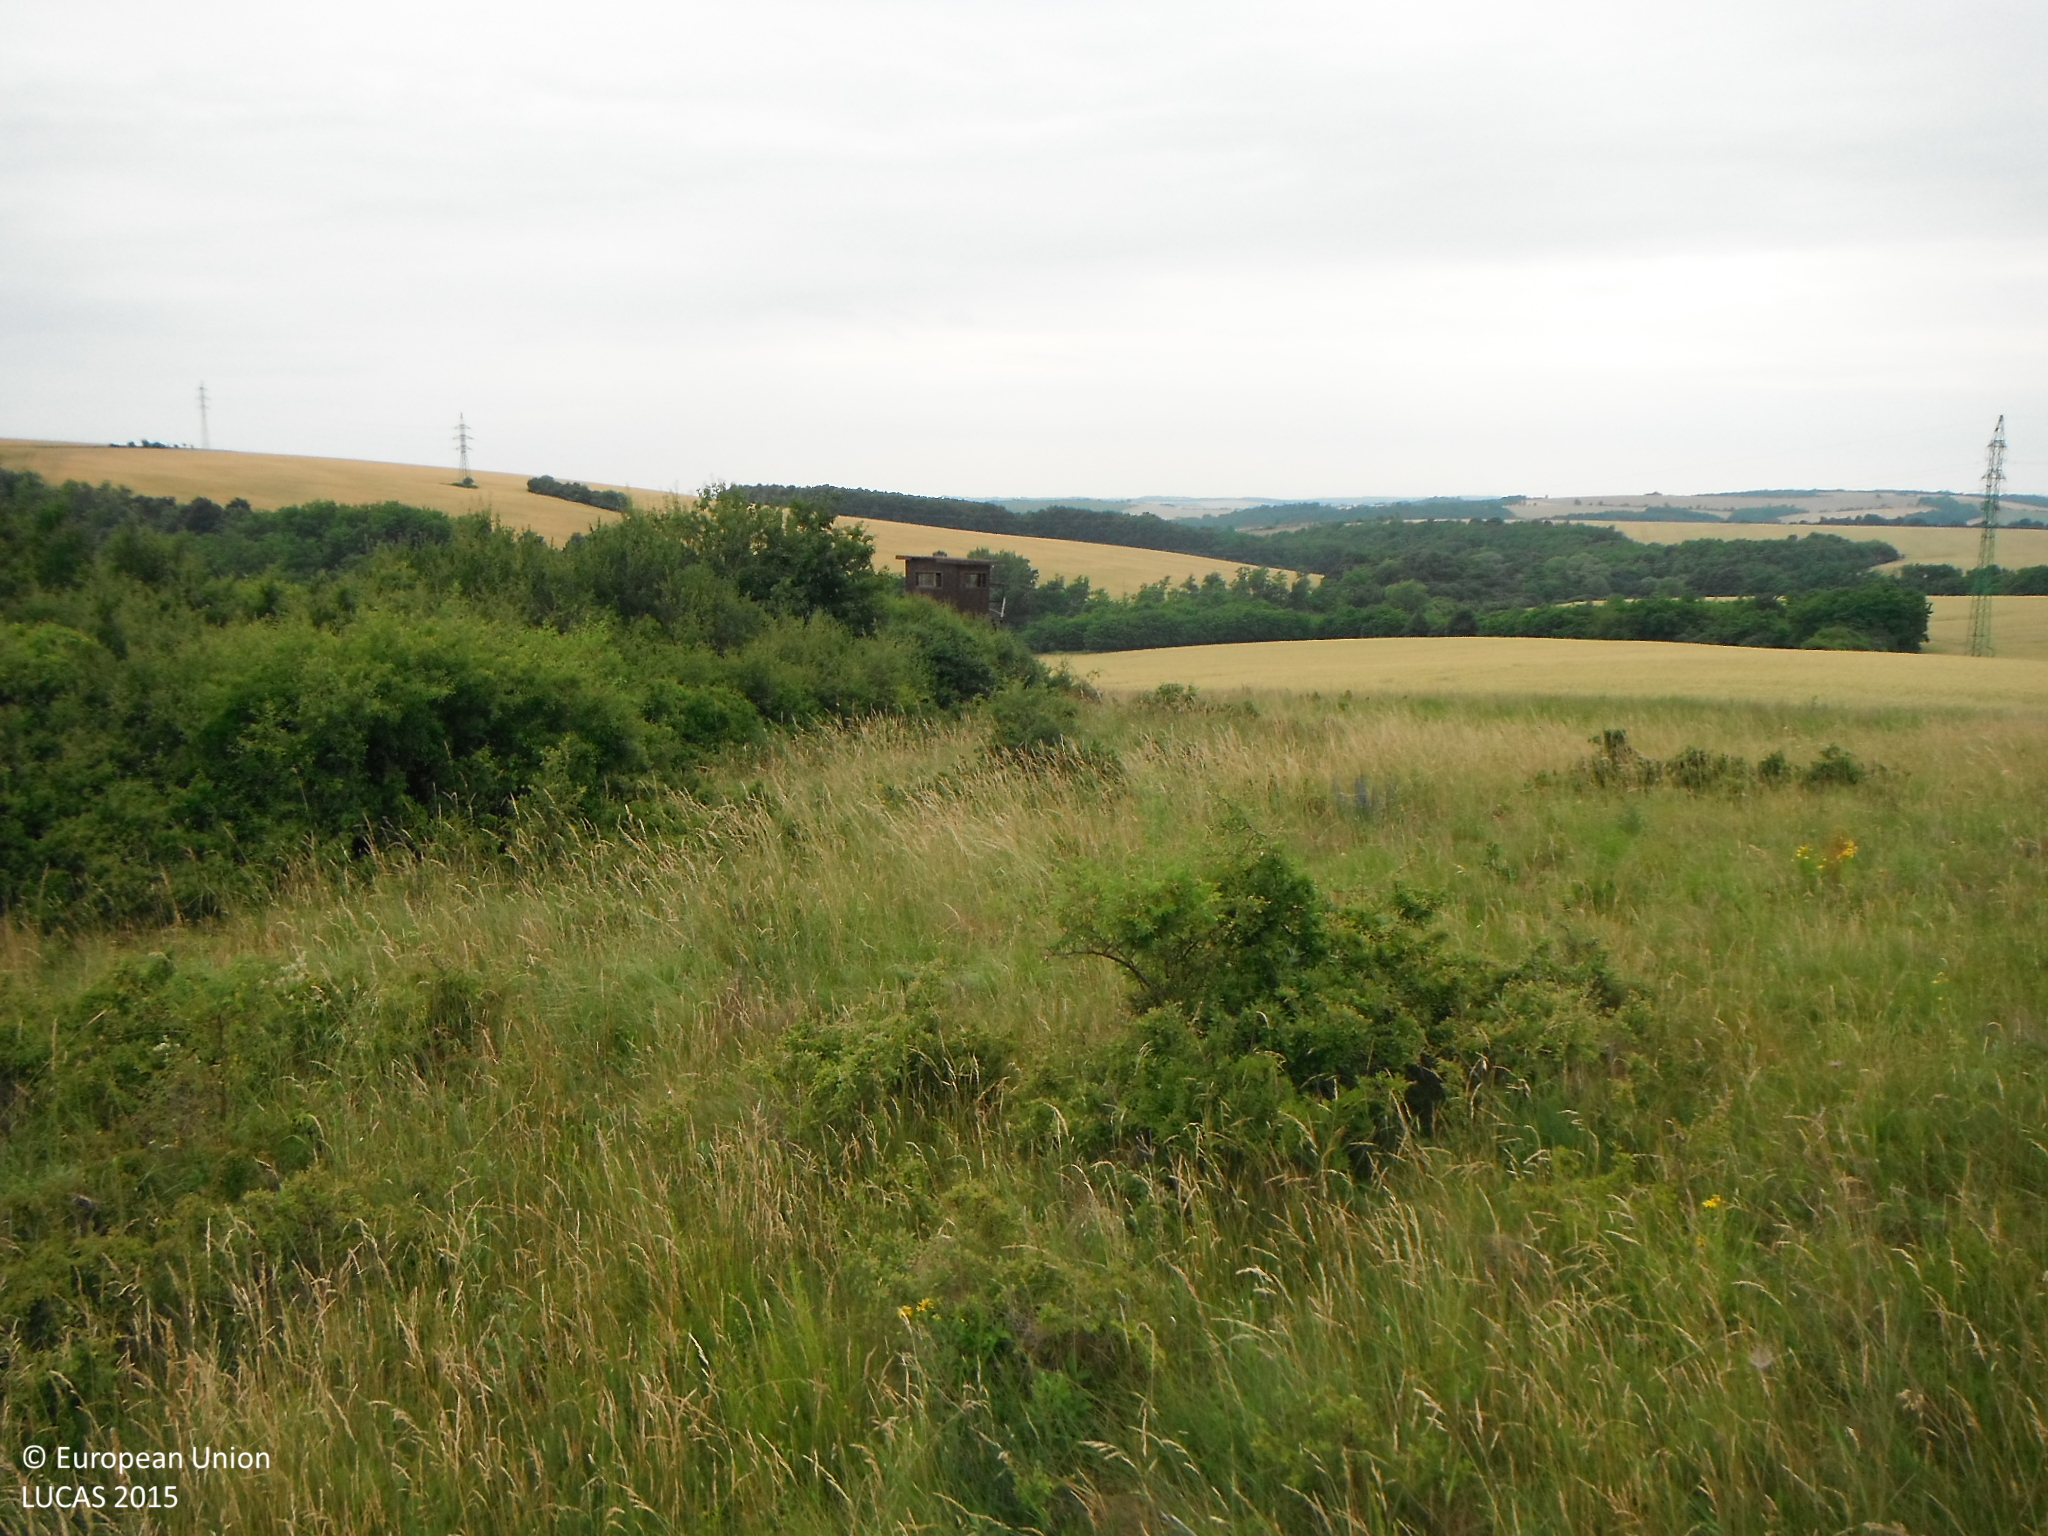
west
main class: Grassland
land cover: Grassland with sparse tree/shrub cover
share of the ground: > 75 %
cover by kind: herbaceous plants 85 %, shrubs 10 %, broadleaved forest trees 5 %
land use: Semi-natural and natural areas not in use
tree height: < 5 m
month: June
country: SK
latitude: 48.1279
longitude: 18.9811
